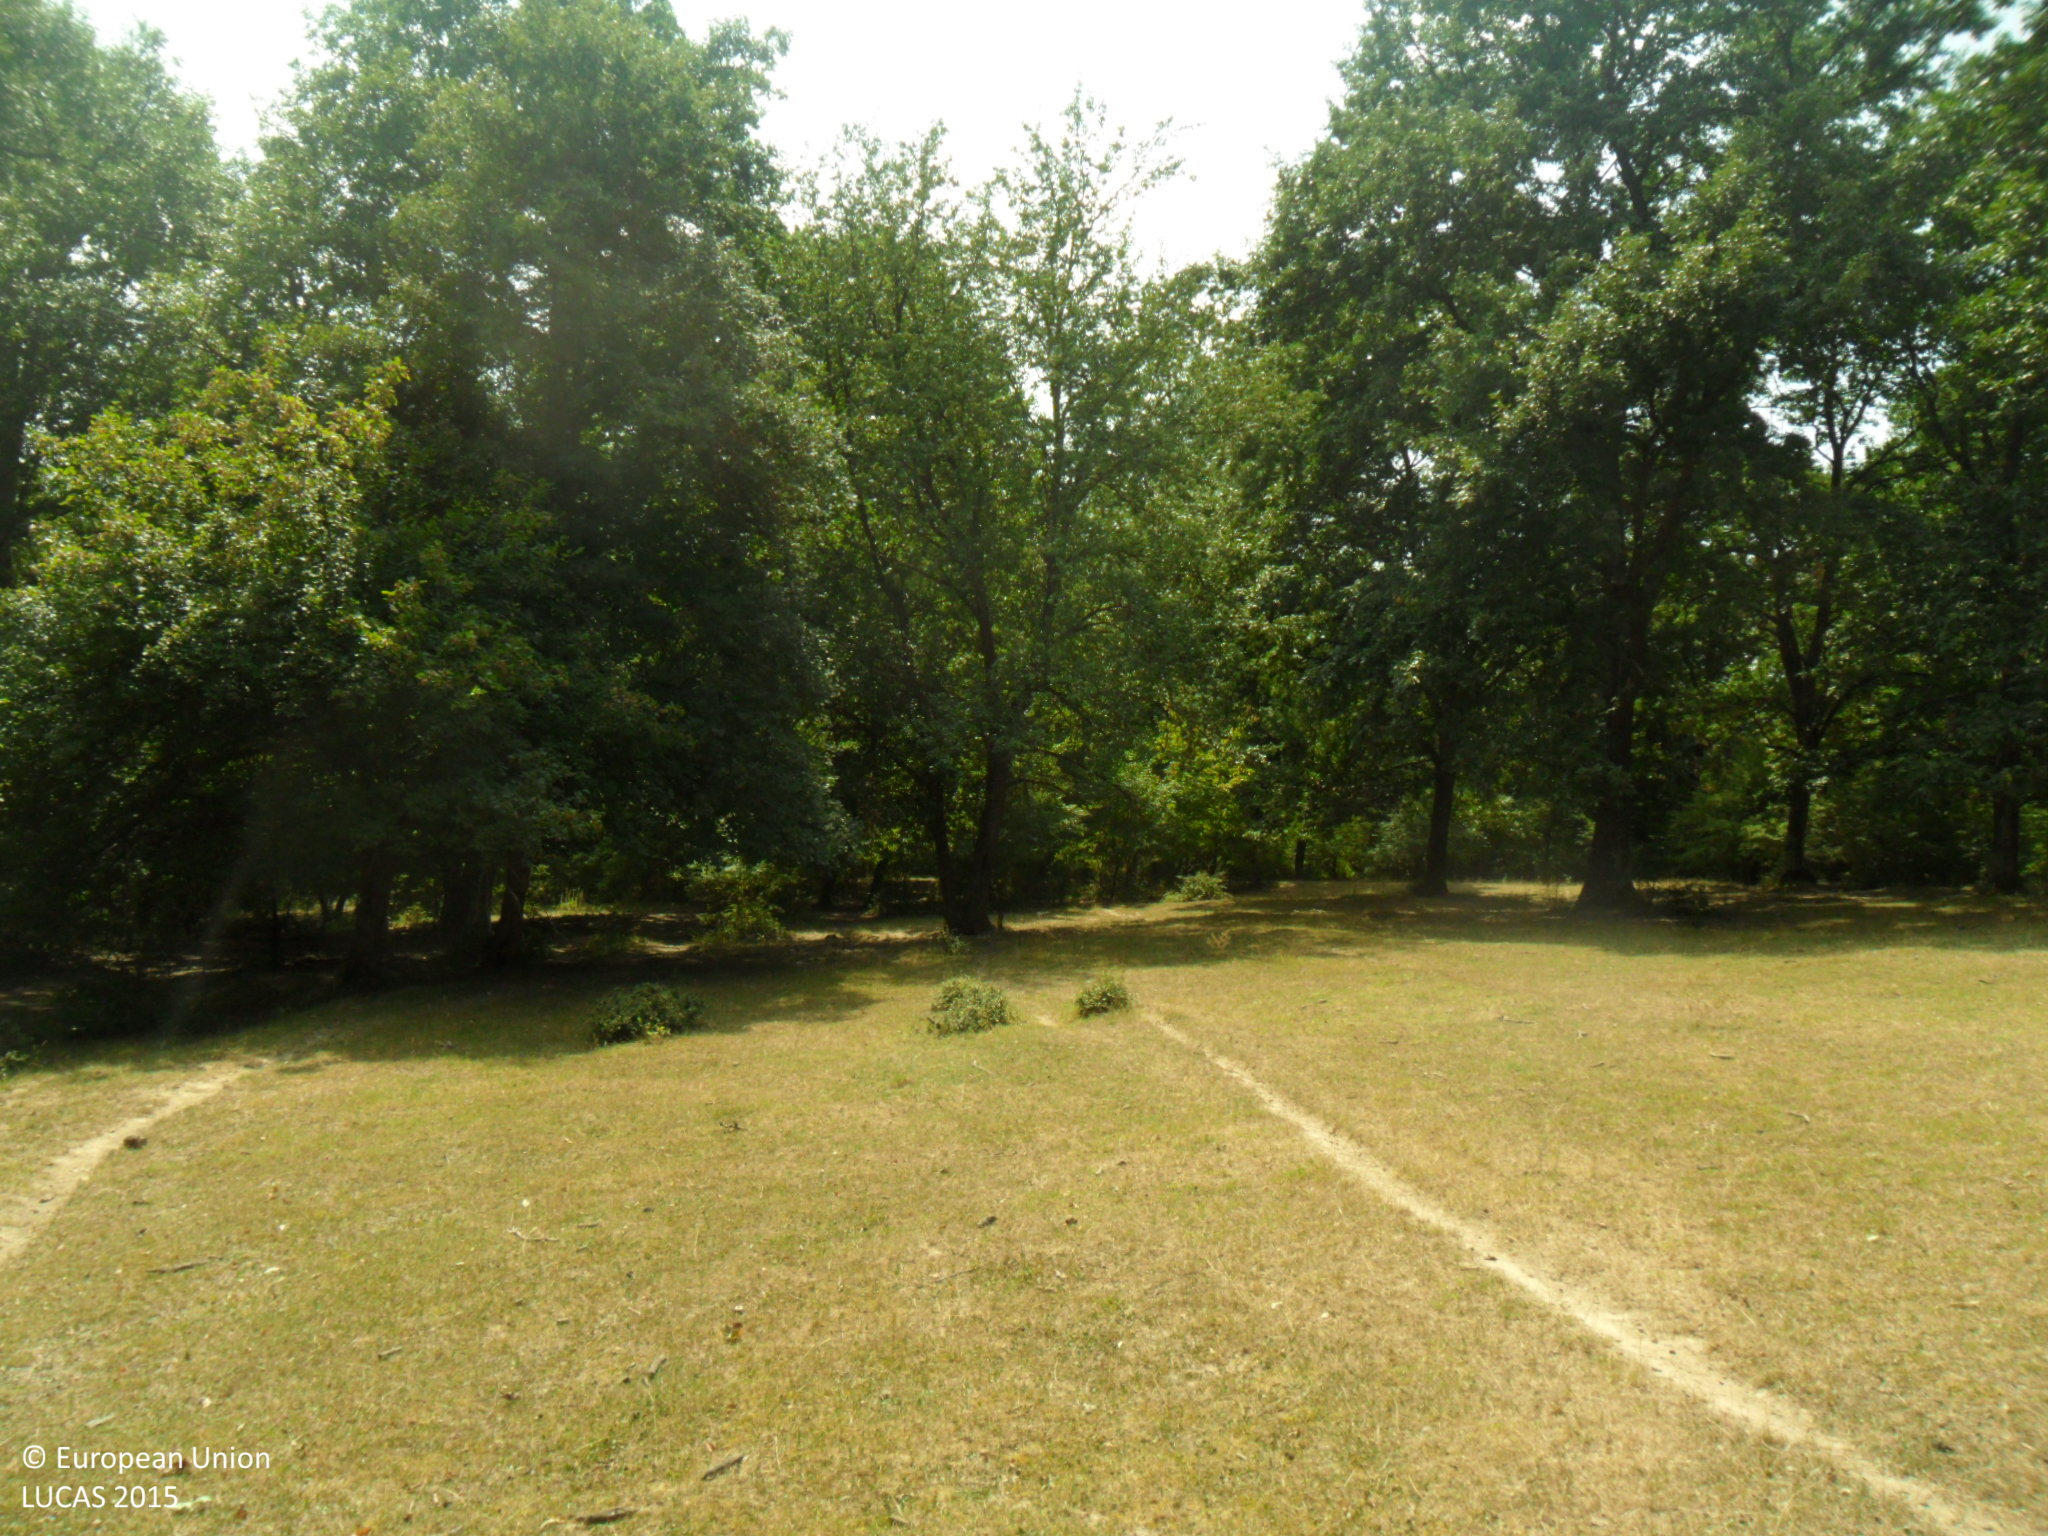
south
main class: Grassland
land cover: Grassland without tree/shrub cover
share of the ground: > 75 %
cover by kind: herbaceous plants 100 %
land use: Agriculture (excluding fallow land and kitchen gardens)
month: August
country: BG
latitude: 43.0348
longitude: 26.7357
